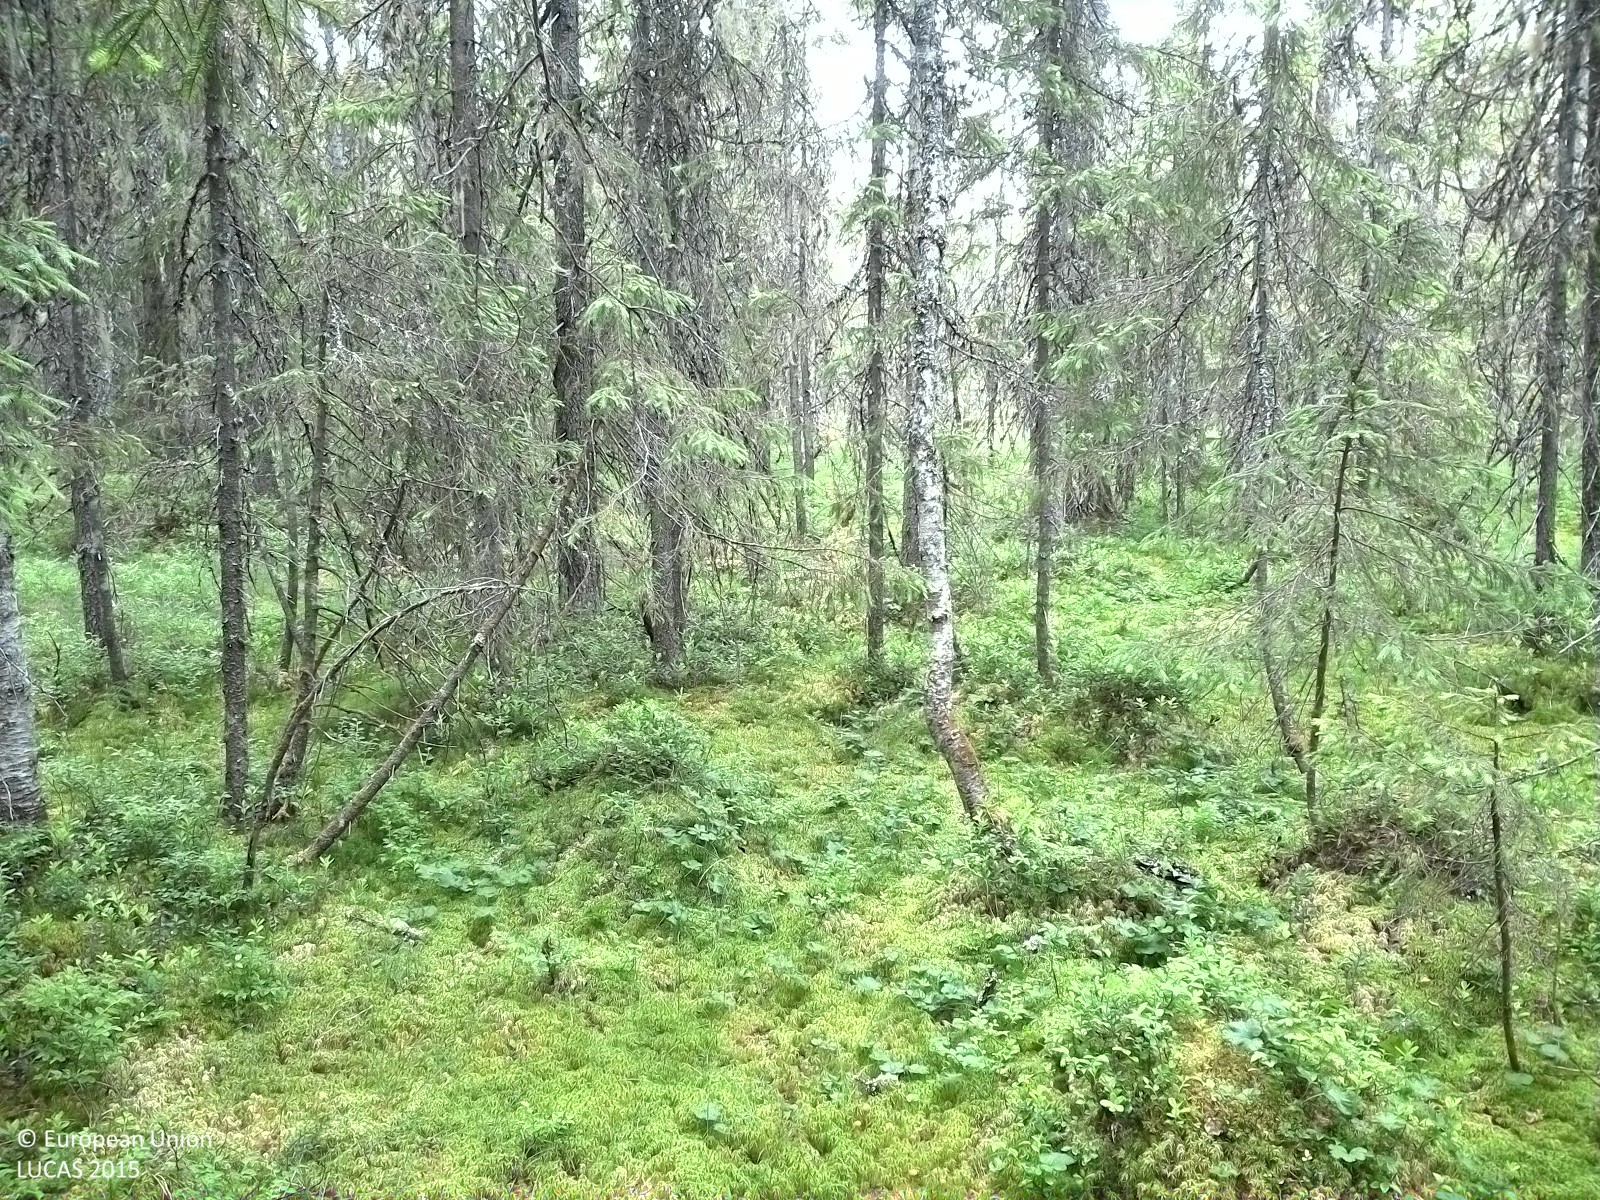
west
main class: Woodland
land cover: Spruce dominated coniferous woodland
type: boreal forest
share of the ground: 25 - 50 %
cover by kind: coniferous forest trees 45 %, lichens and mosses 30 %, shrubs 20 %, broadleaved forest trees 5 %
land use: Forestry
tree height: > 5 m
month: July
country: SE
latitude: 62.1084
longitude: 16.9373
